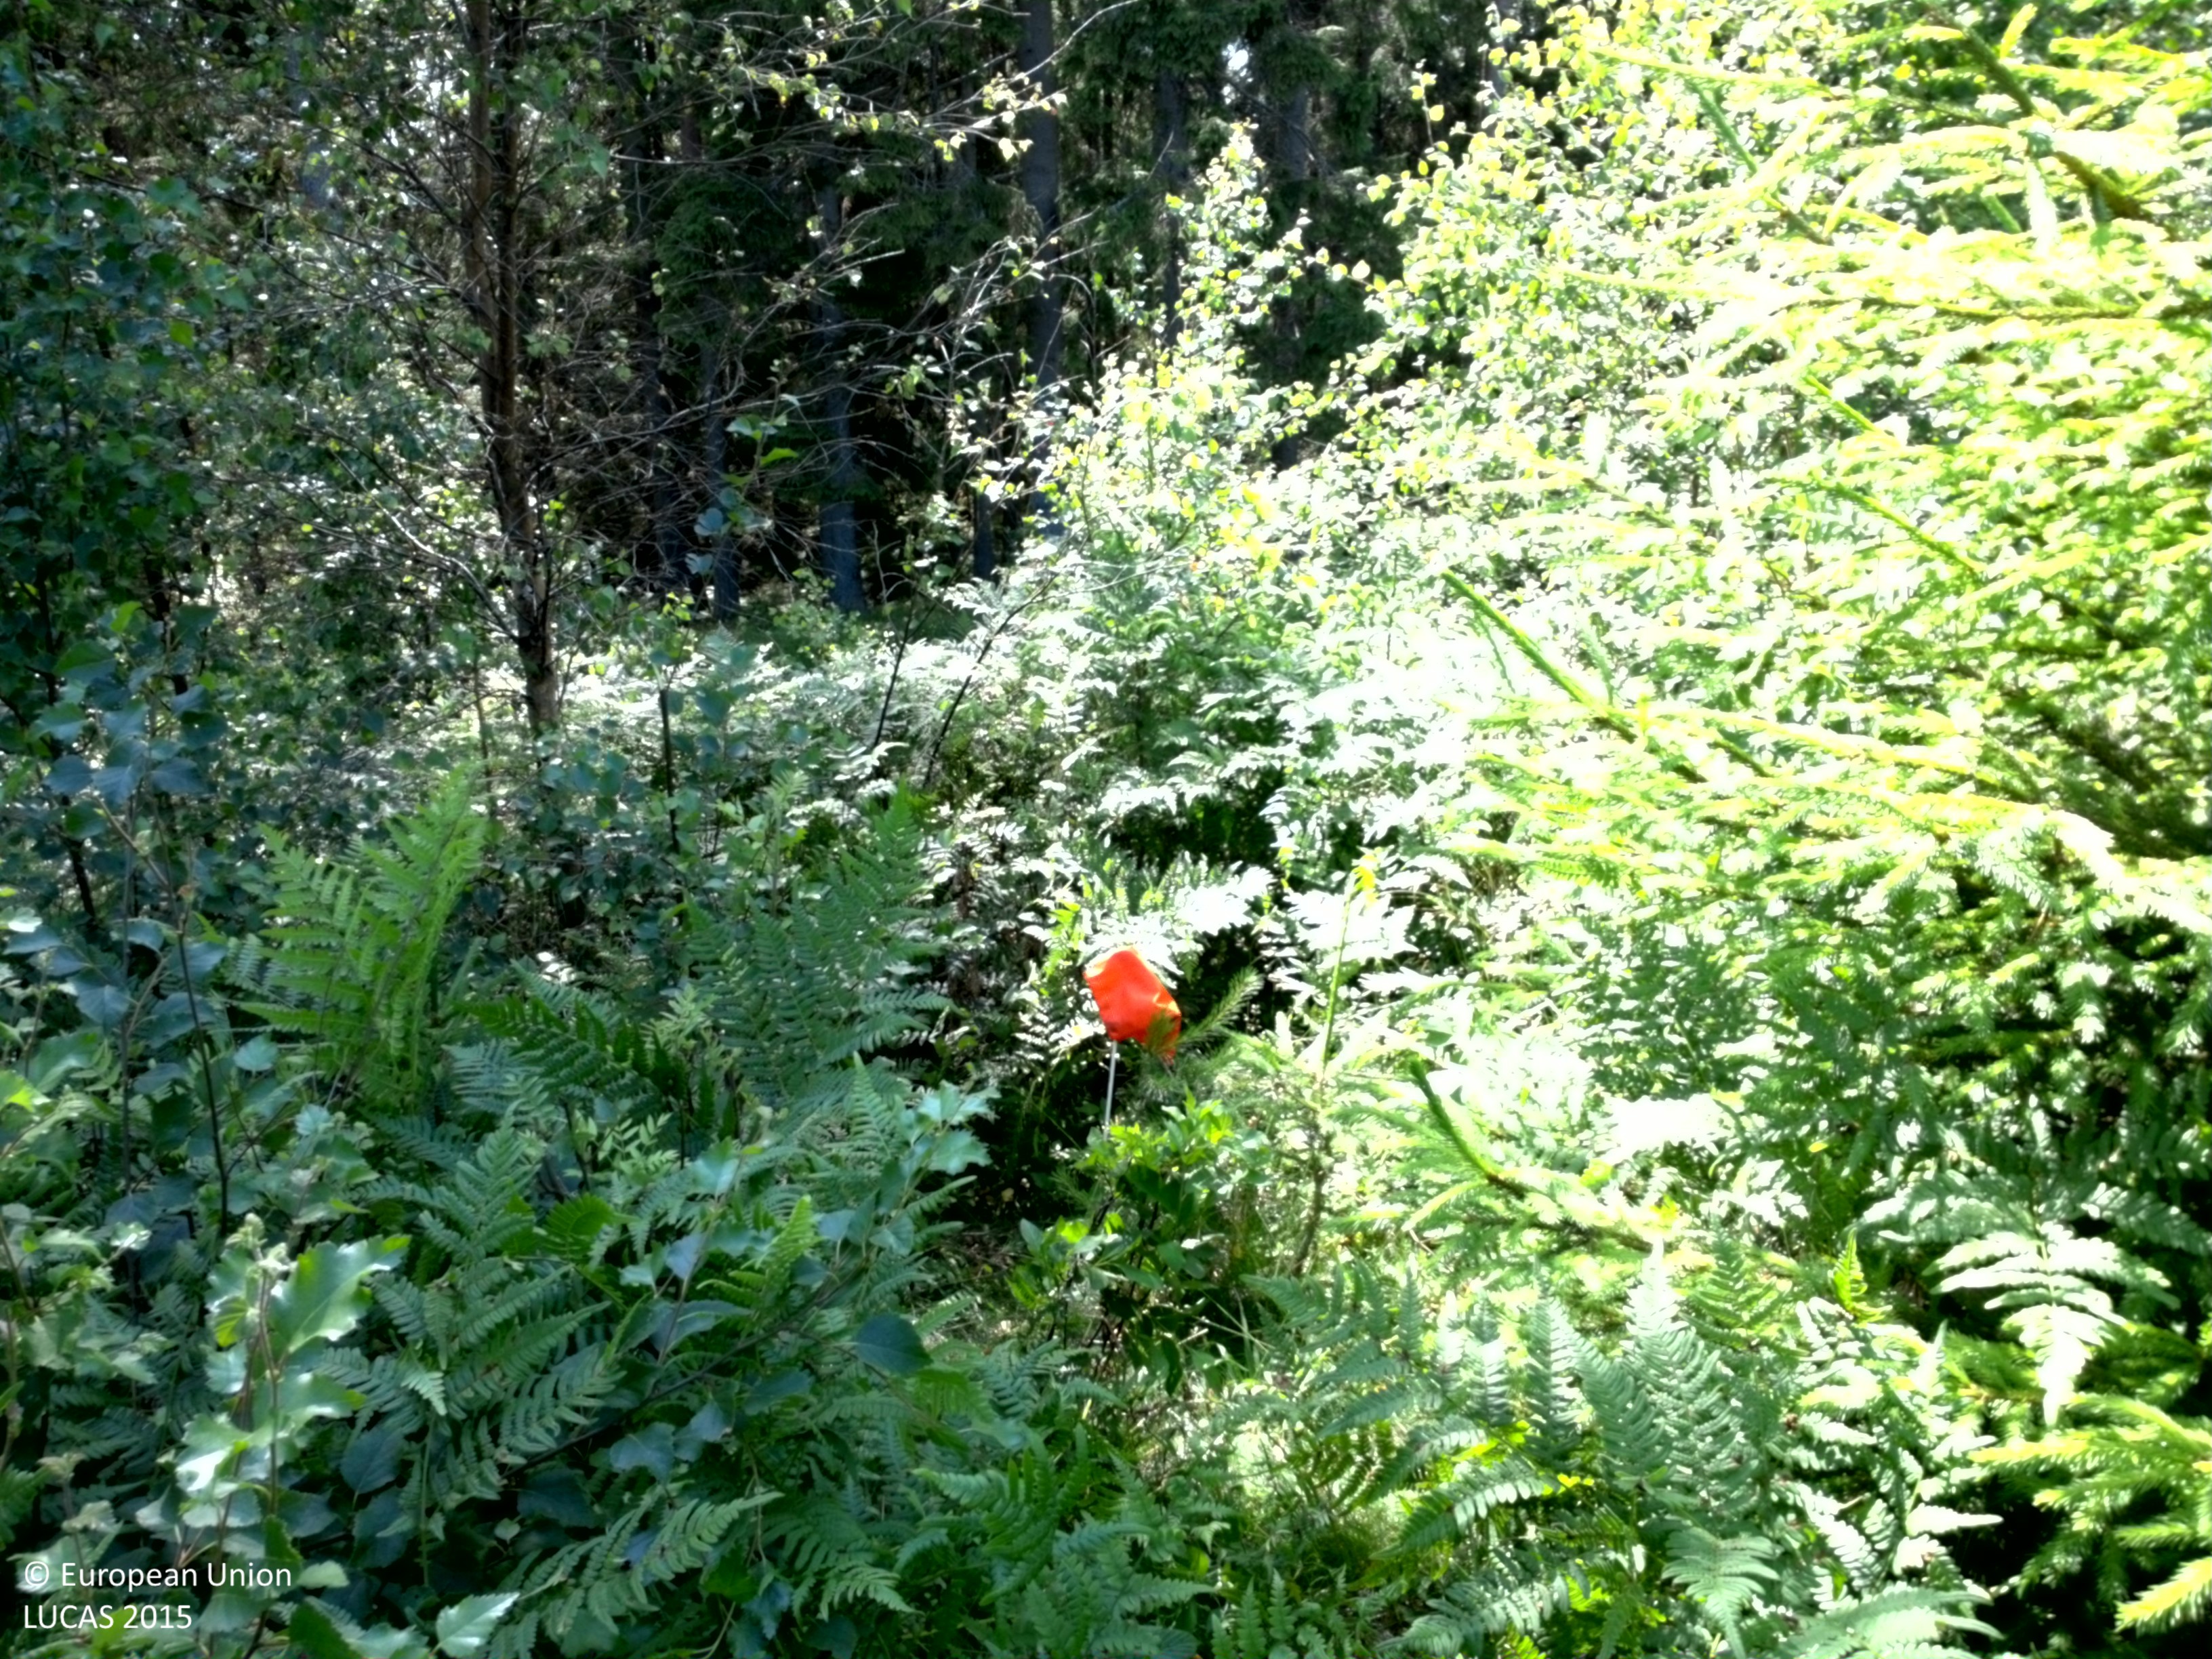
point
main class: Woodland
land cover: Spruce dominated mixed woodland
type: boreal forest
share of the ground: 50 - 75 %
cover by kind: herbaceous plants 40 %, coniferous forest trees 35 %, broadleaved forest trees 25 %
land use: Forestry
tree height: < 5 m
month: July
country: SE
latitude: 58.8227
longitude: 14.6860
